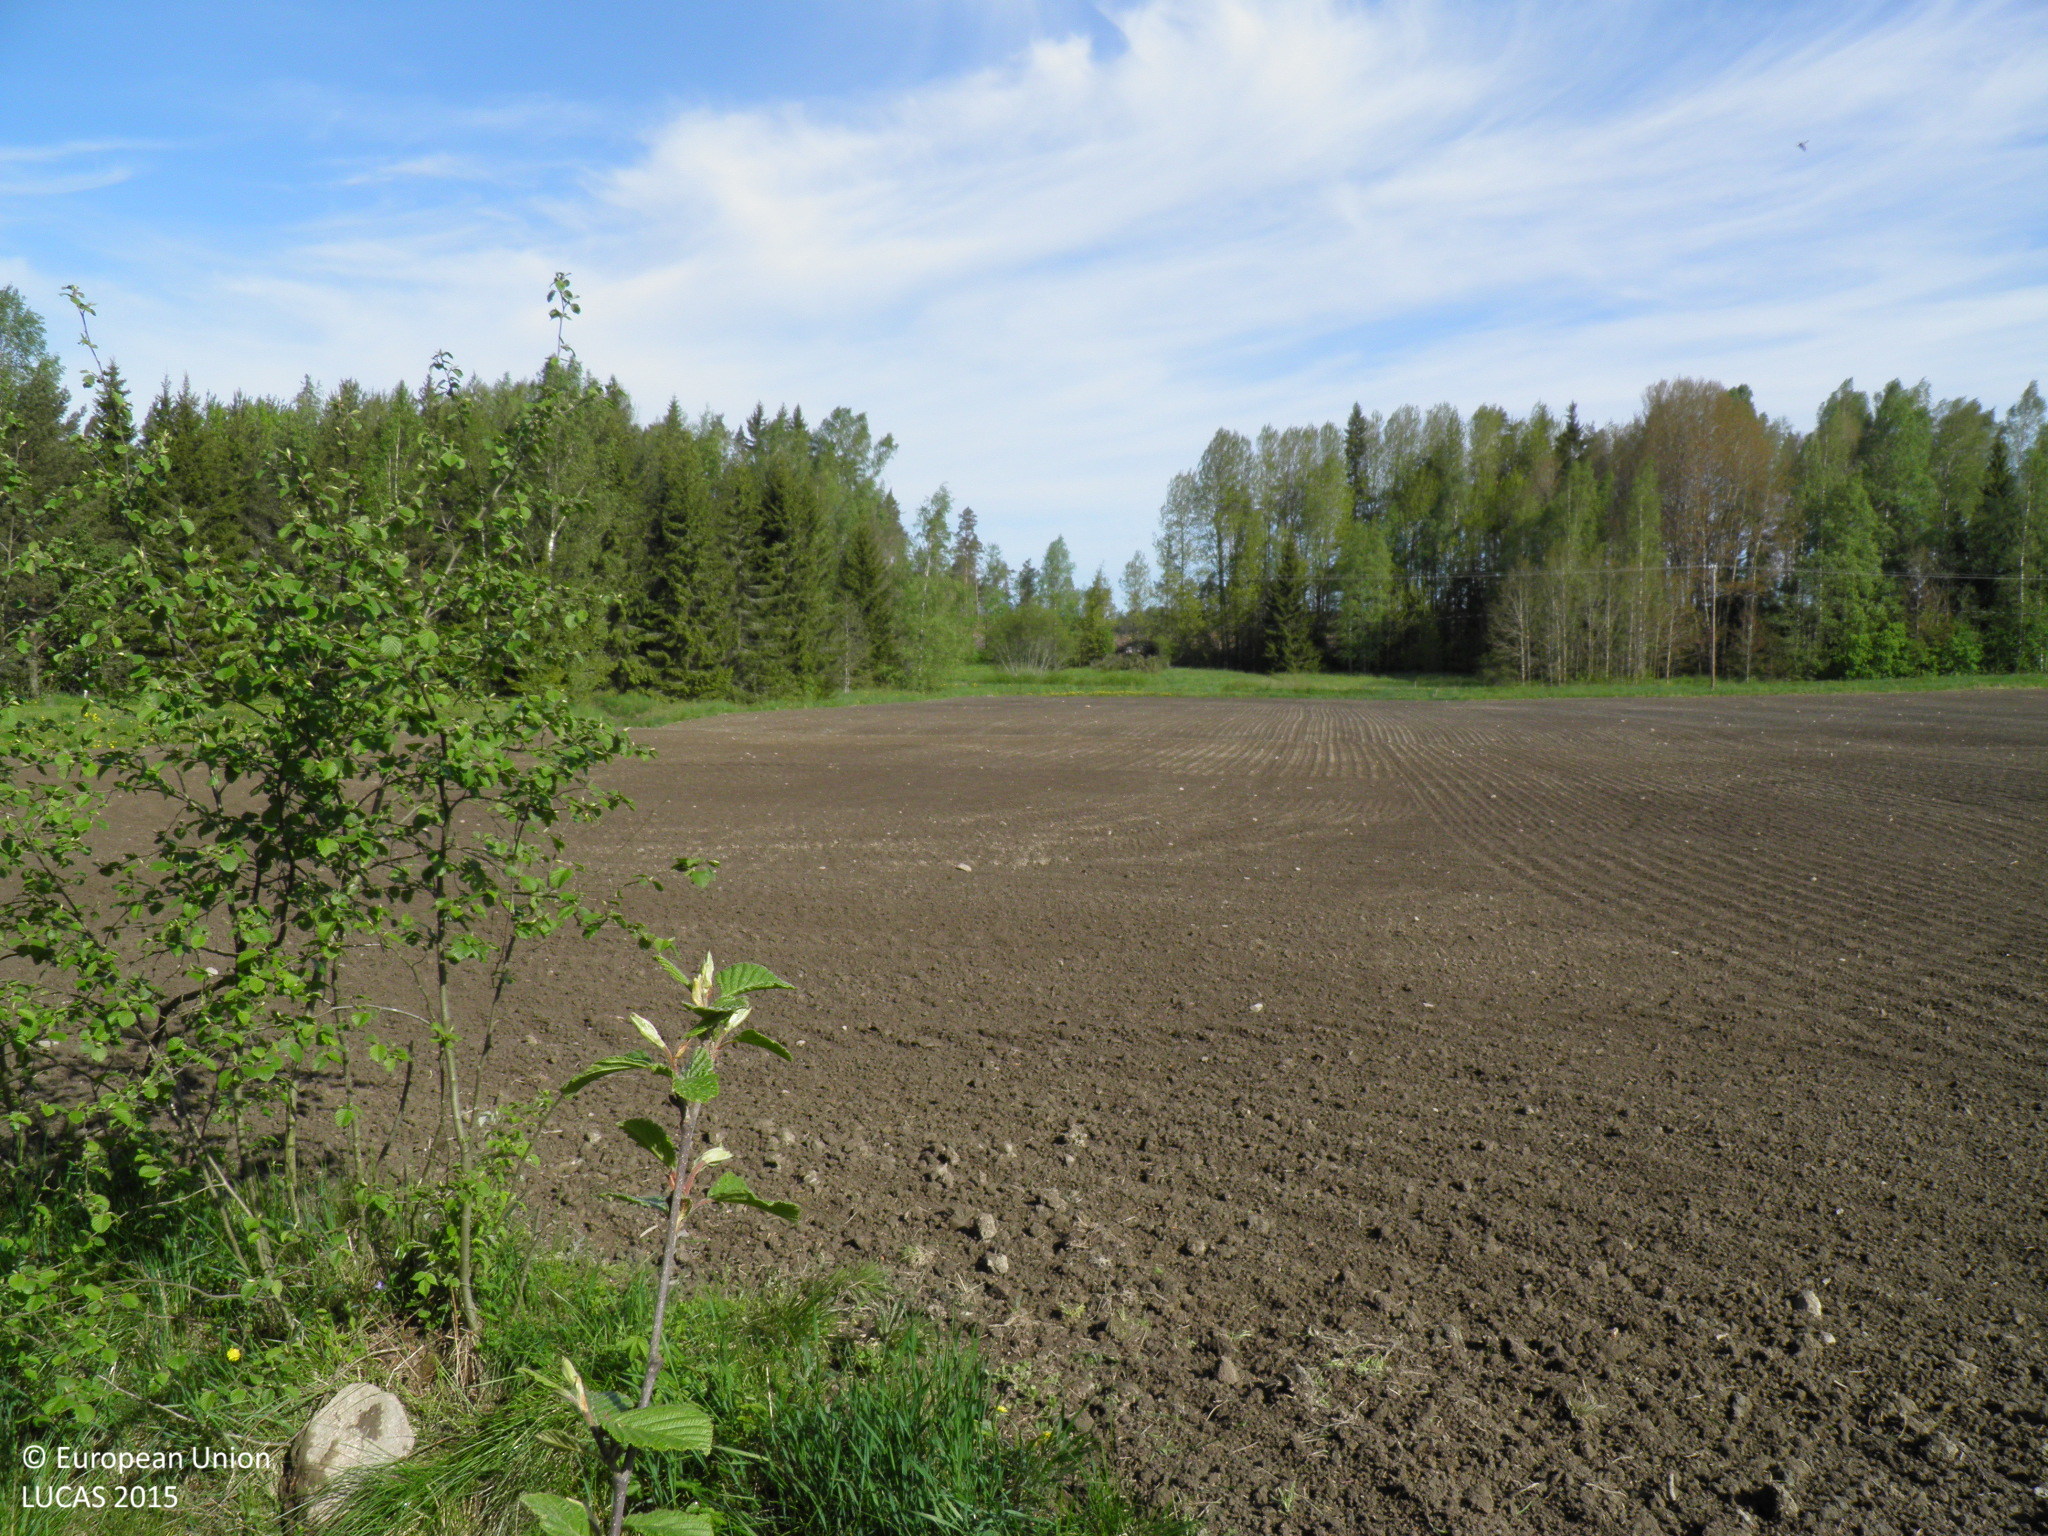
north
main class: Cropland
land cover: Common wheat
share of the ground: < 10 %
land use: Agriculture (excluding fallow land and kitchen gardens)
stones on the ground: < 10 %
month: June
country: FI
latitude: 60.5272
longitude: 22.5891
